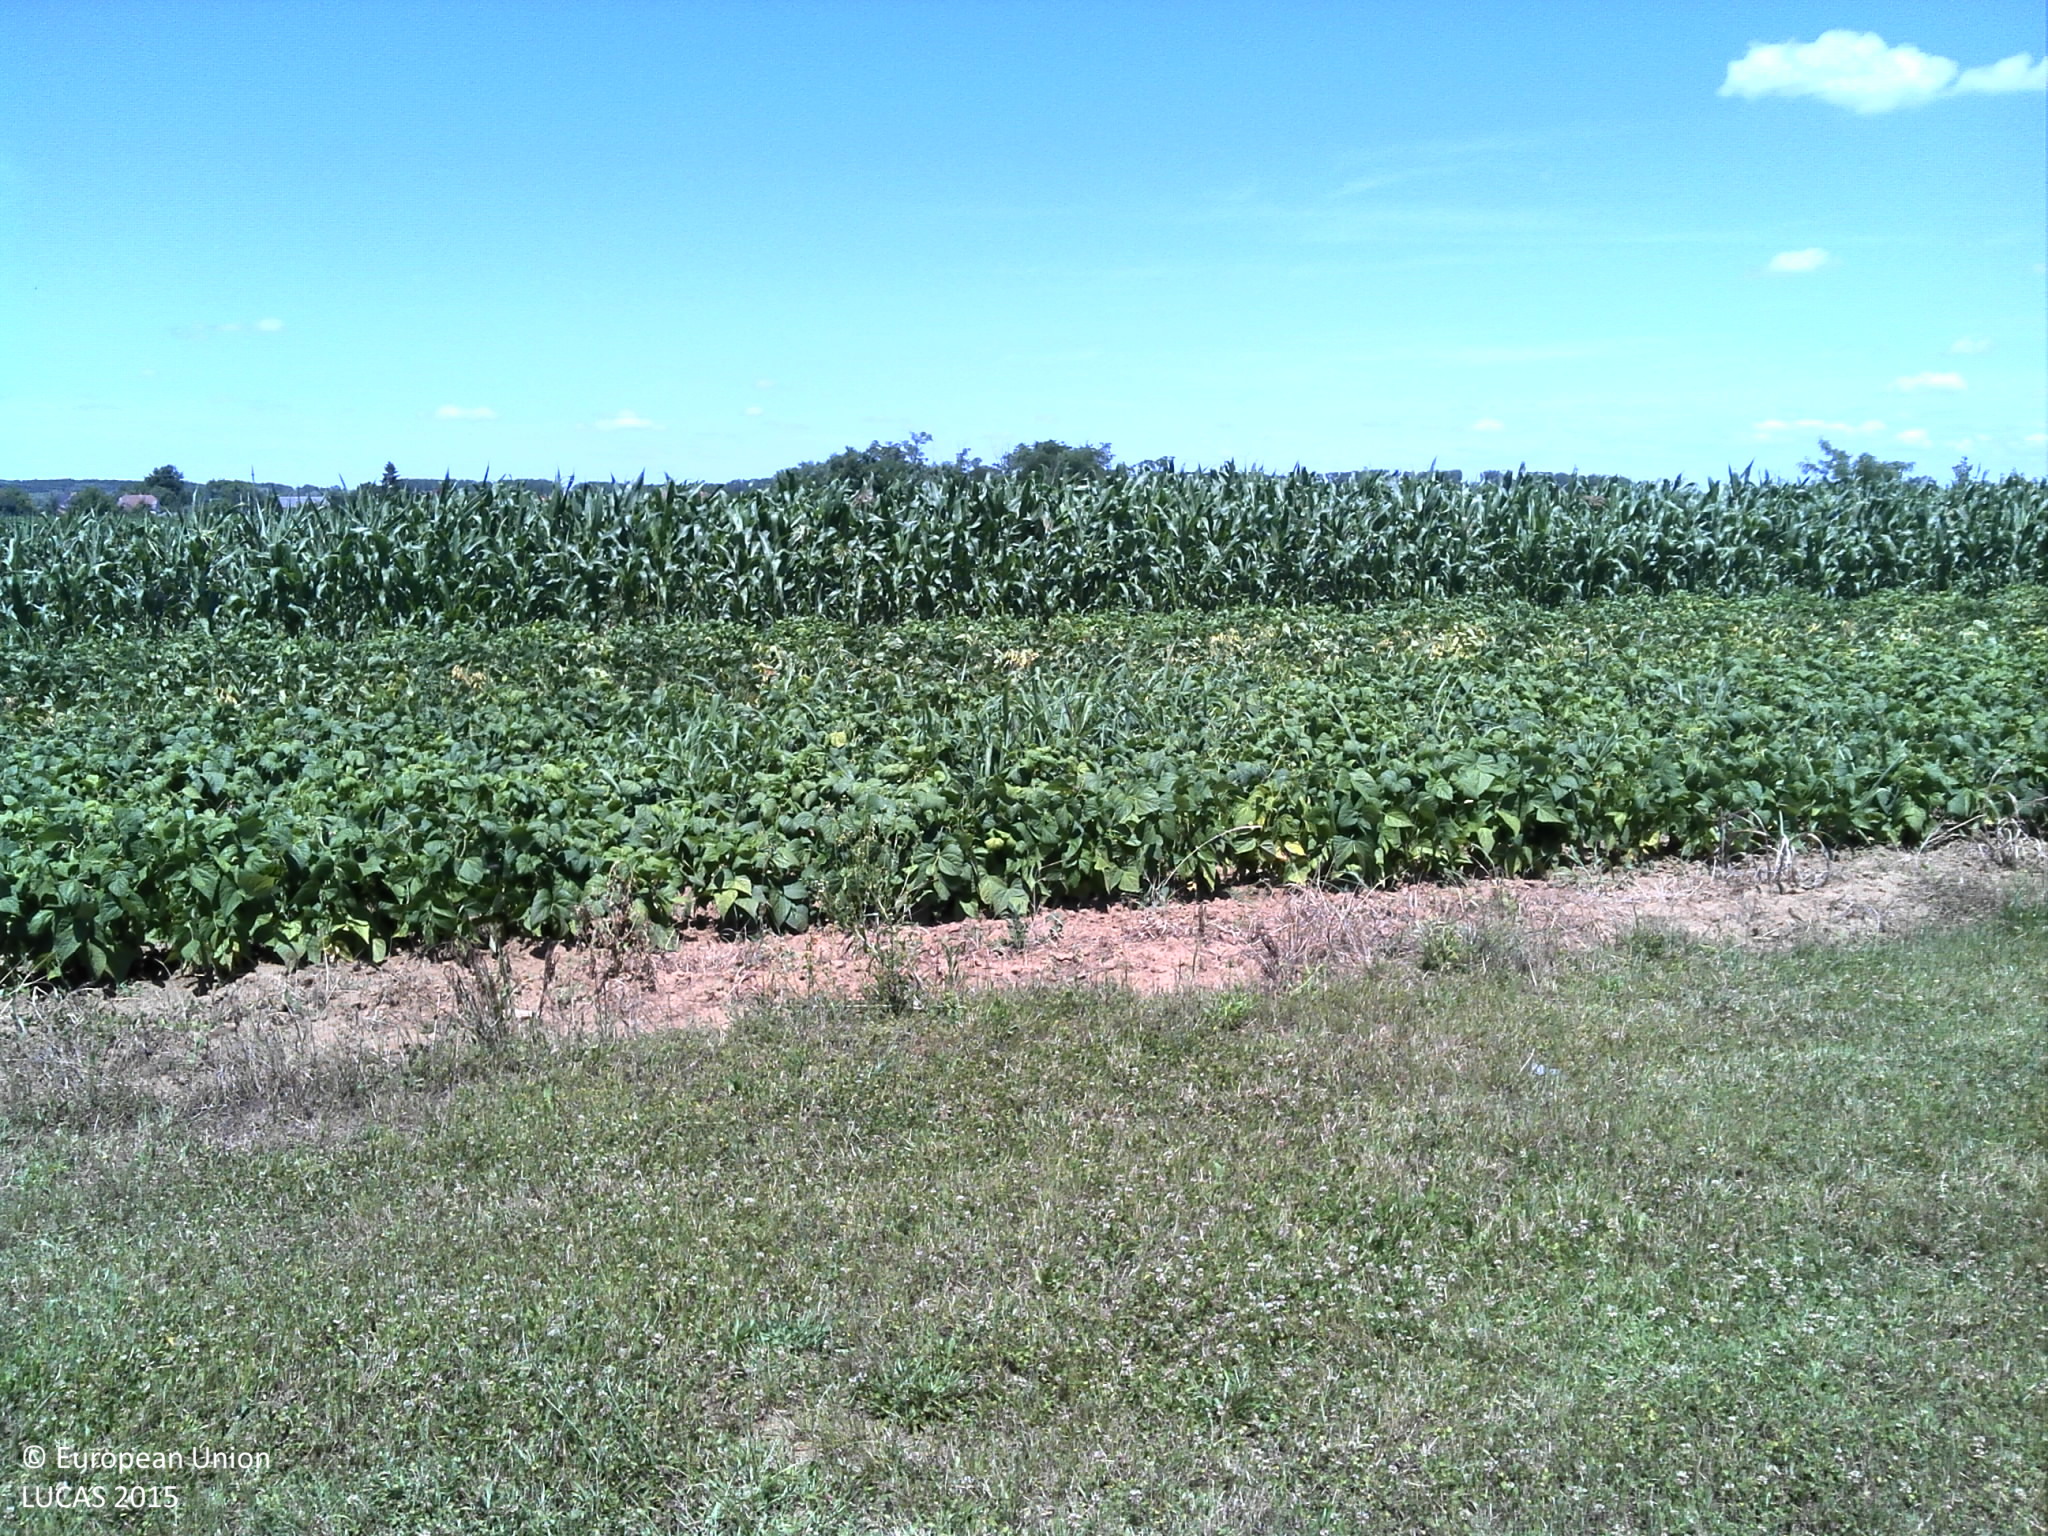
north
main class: Grassland
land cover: Grassland without tree/shrub cover
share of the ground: > 75 %
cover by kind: herbaceous plants 100 %
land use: Semi-natural and natural areas not in use
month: June
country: HR
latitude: 45.7567
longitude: 18.0659
